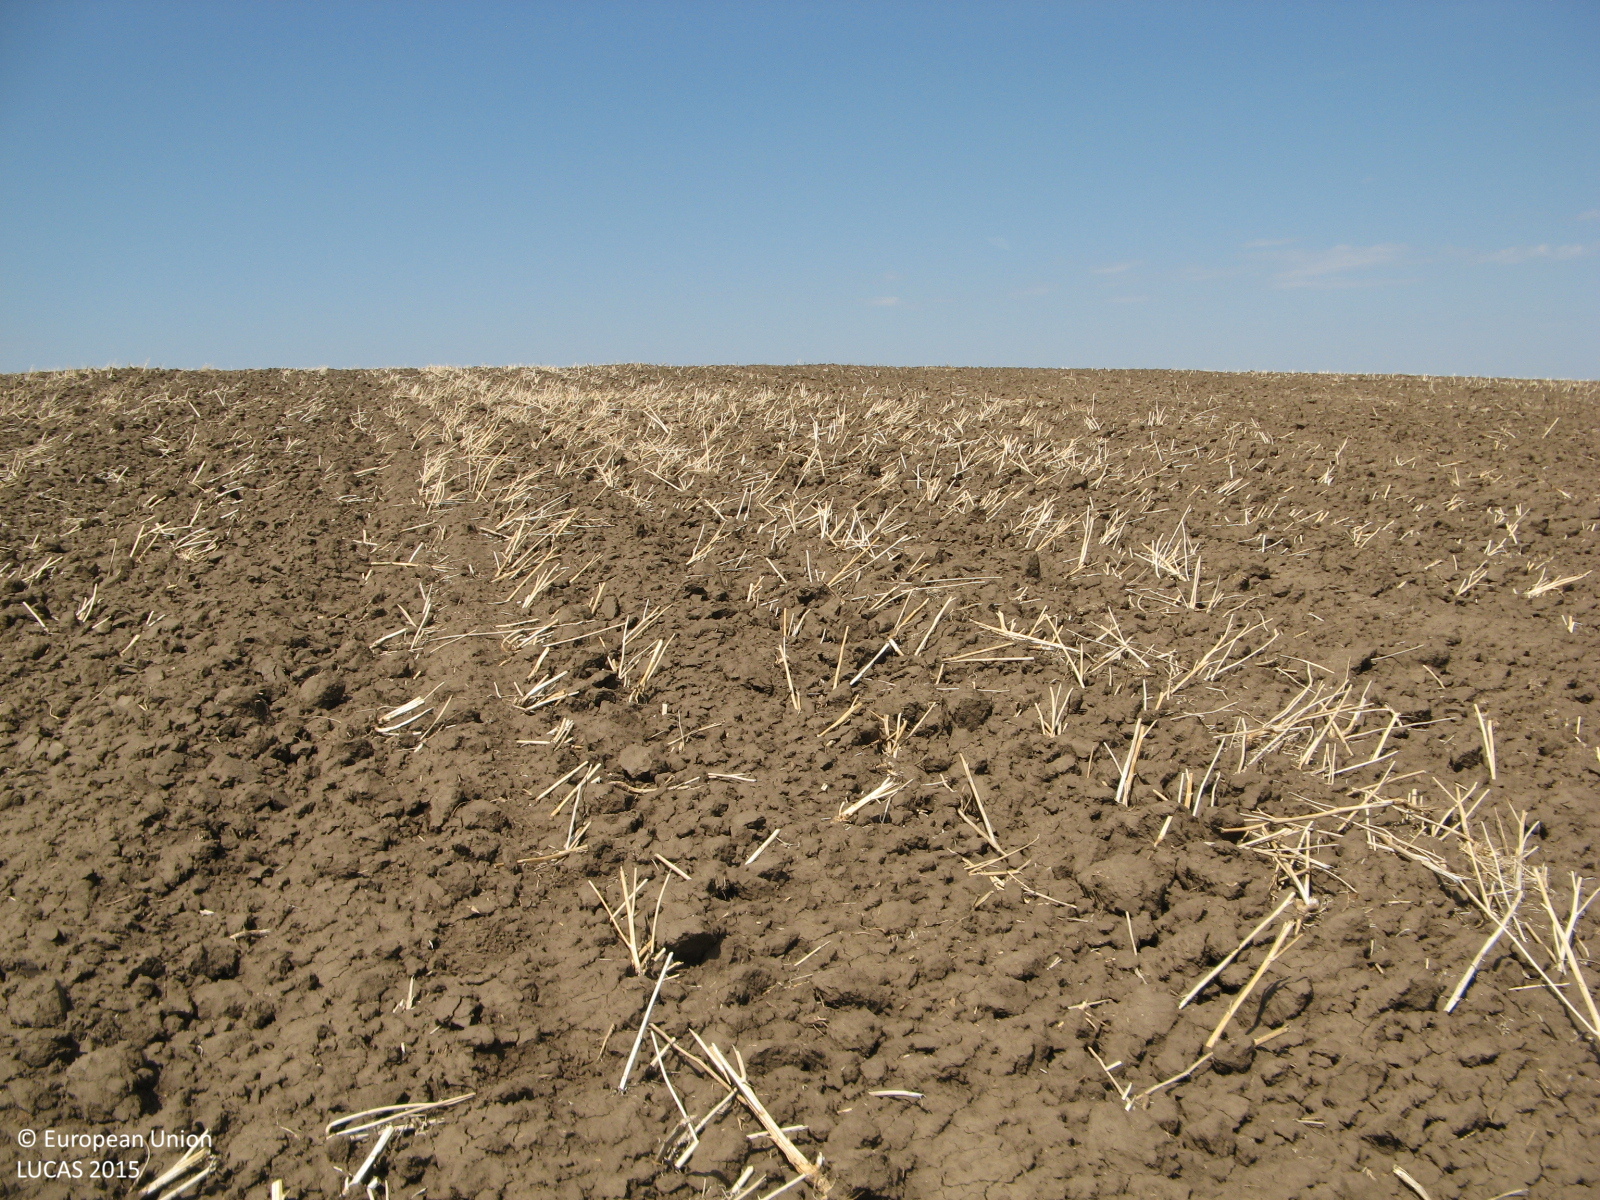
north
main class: Cropland
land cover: Rape and turnip rape
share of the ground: < 10 %
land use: Agriculture (excluding fallow land and kitchen gardens)
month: August
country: BG
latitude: 43.4797
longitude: 25.3215
